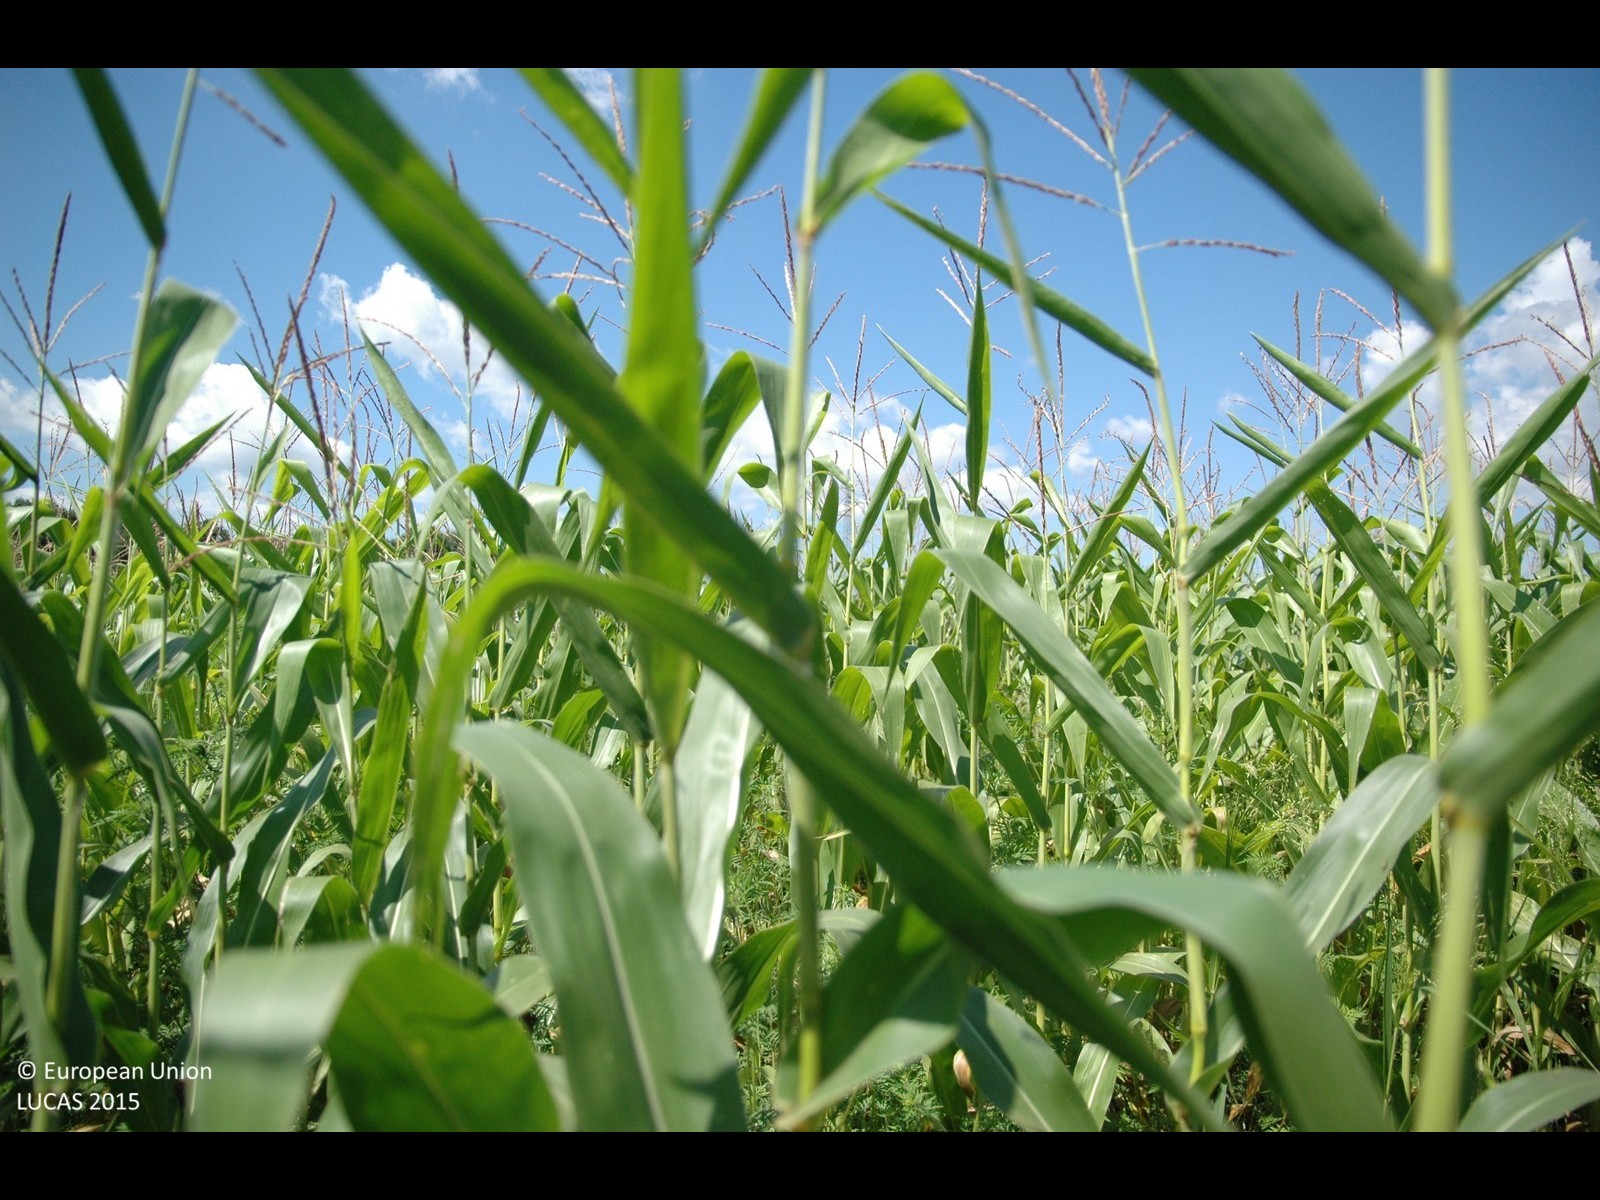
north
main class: Cropland
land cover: Maize
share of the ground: > 75 %
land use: Agriculture (excluding fallow land and kitchen gardens)
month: July
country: HR
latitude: 46.1838
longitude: 16.8808
